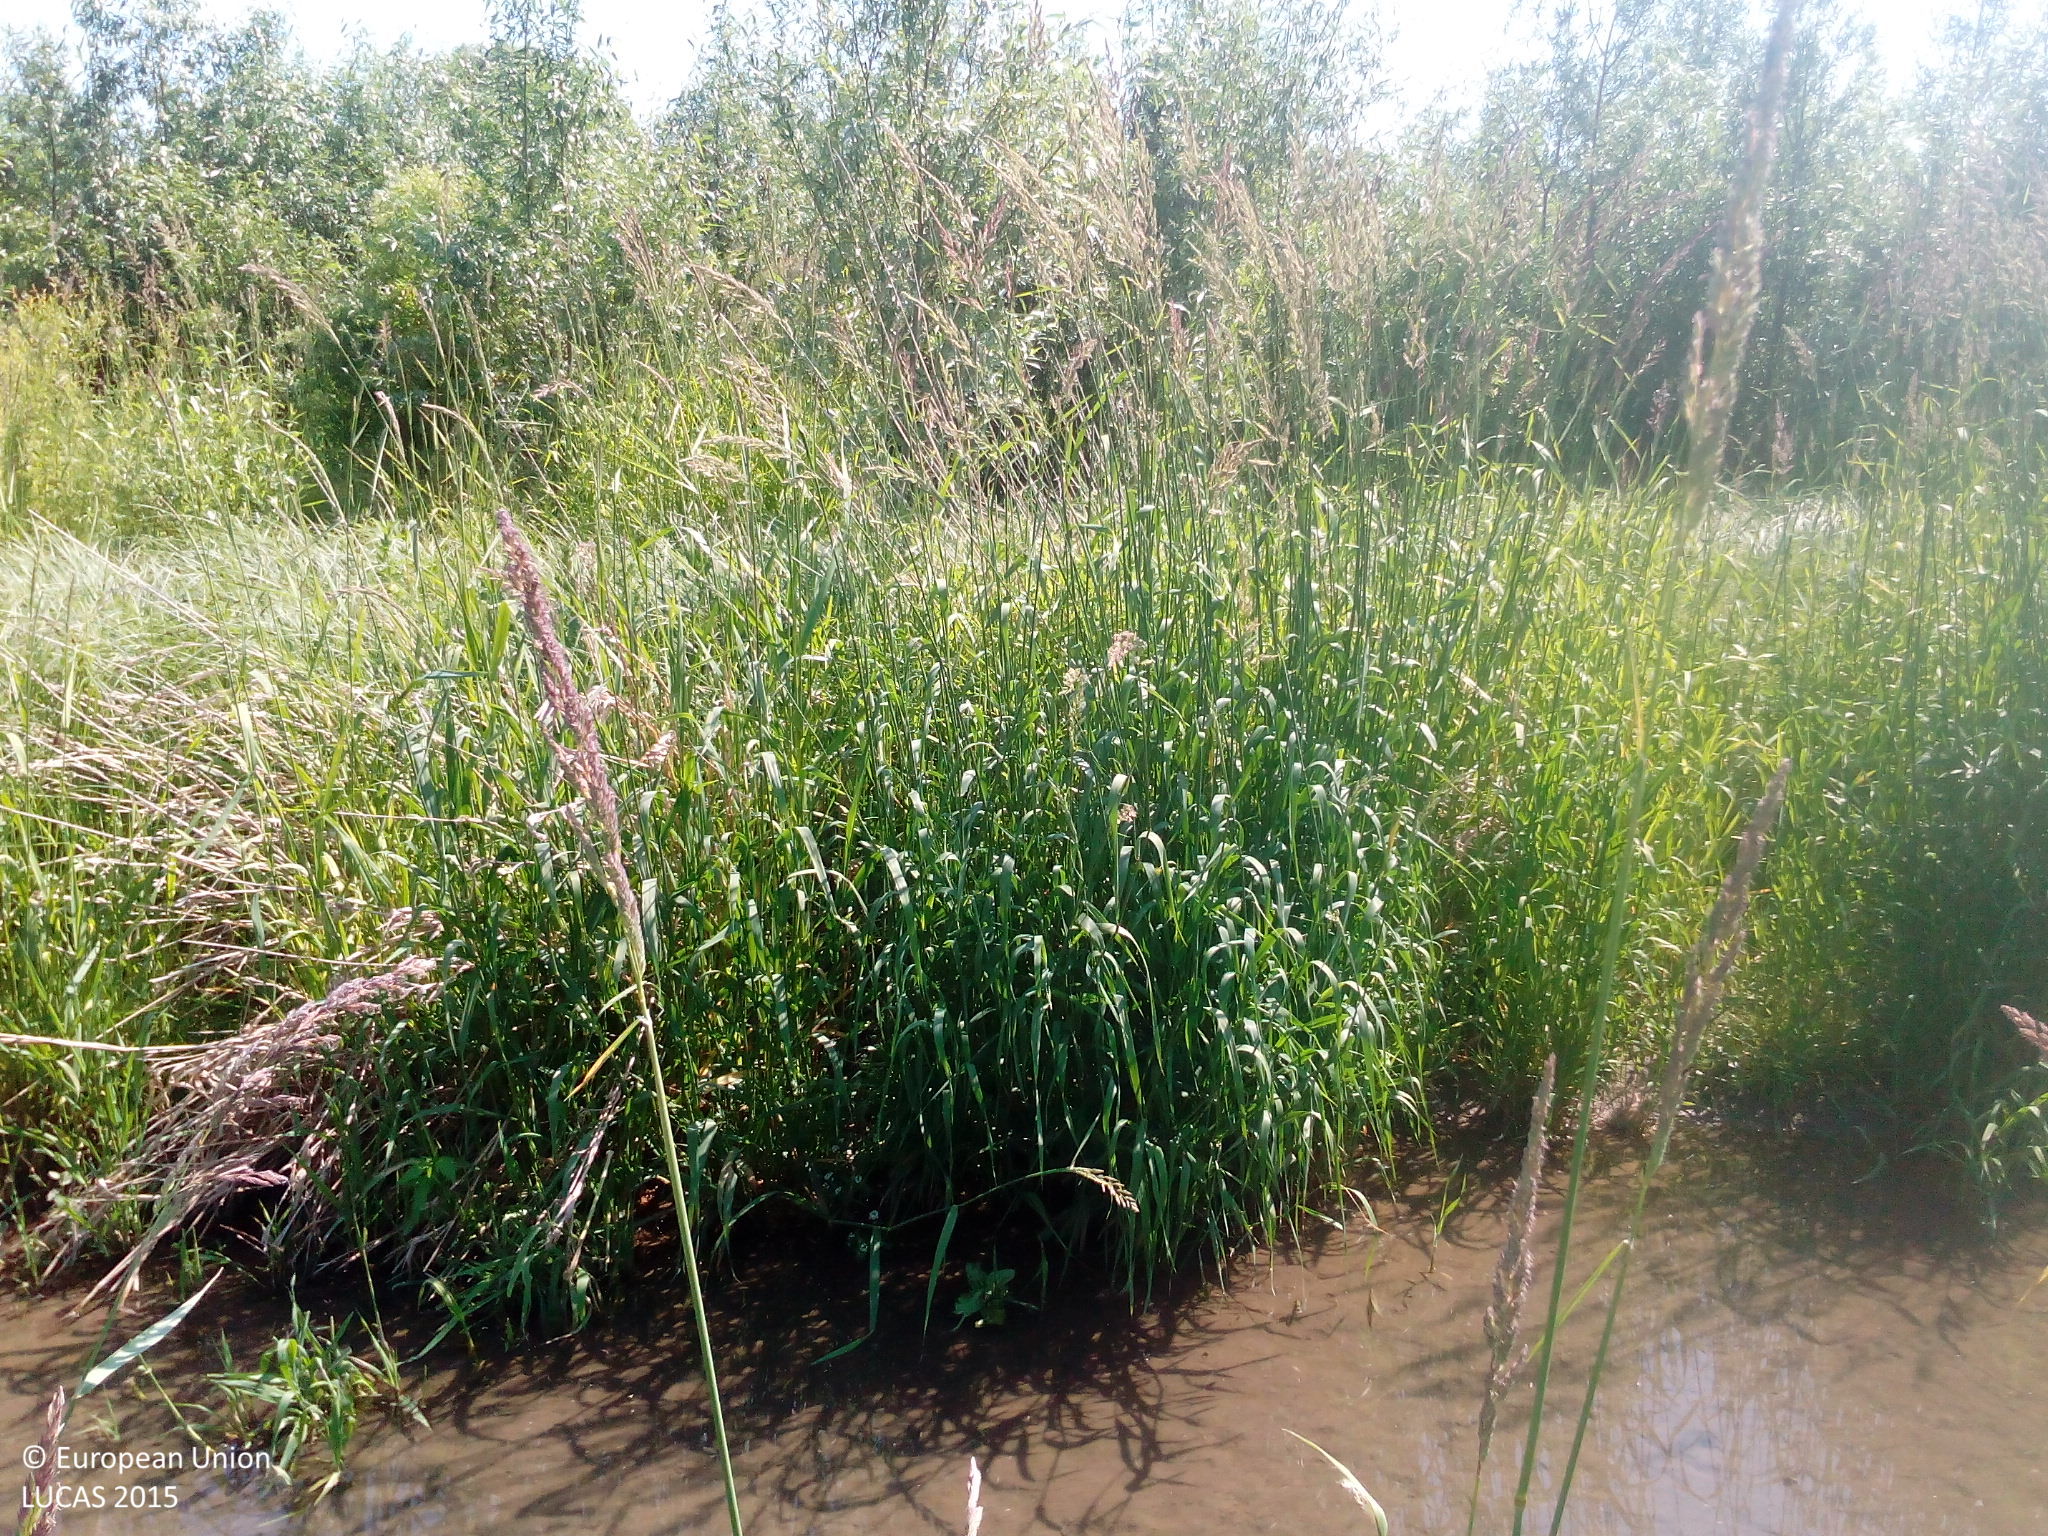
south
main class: Woodland
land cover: Broadleaved woodland
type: floodplain forest
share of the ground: 50 - 75 %
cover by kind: broadleaved forest trees 50 %, herbaceous plants 30 %, shrubs 20 %
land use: Semi-natural and natural areas not in use
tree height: < 5 m
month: June
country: DE
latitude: 49.7556
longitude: 8.1543
